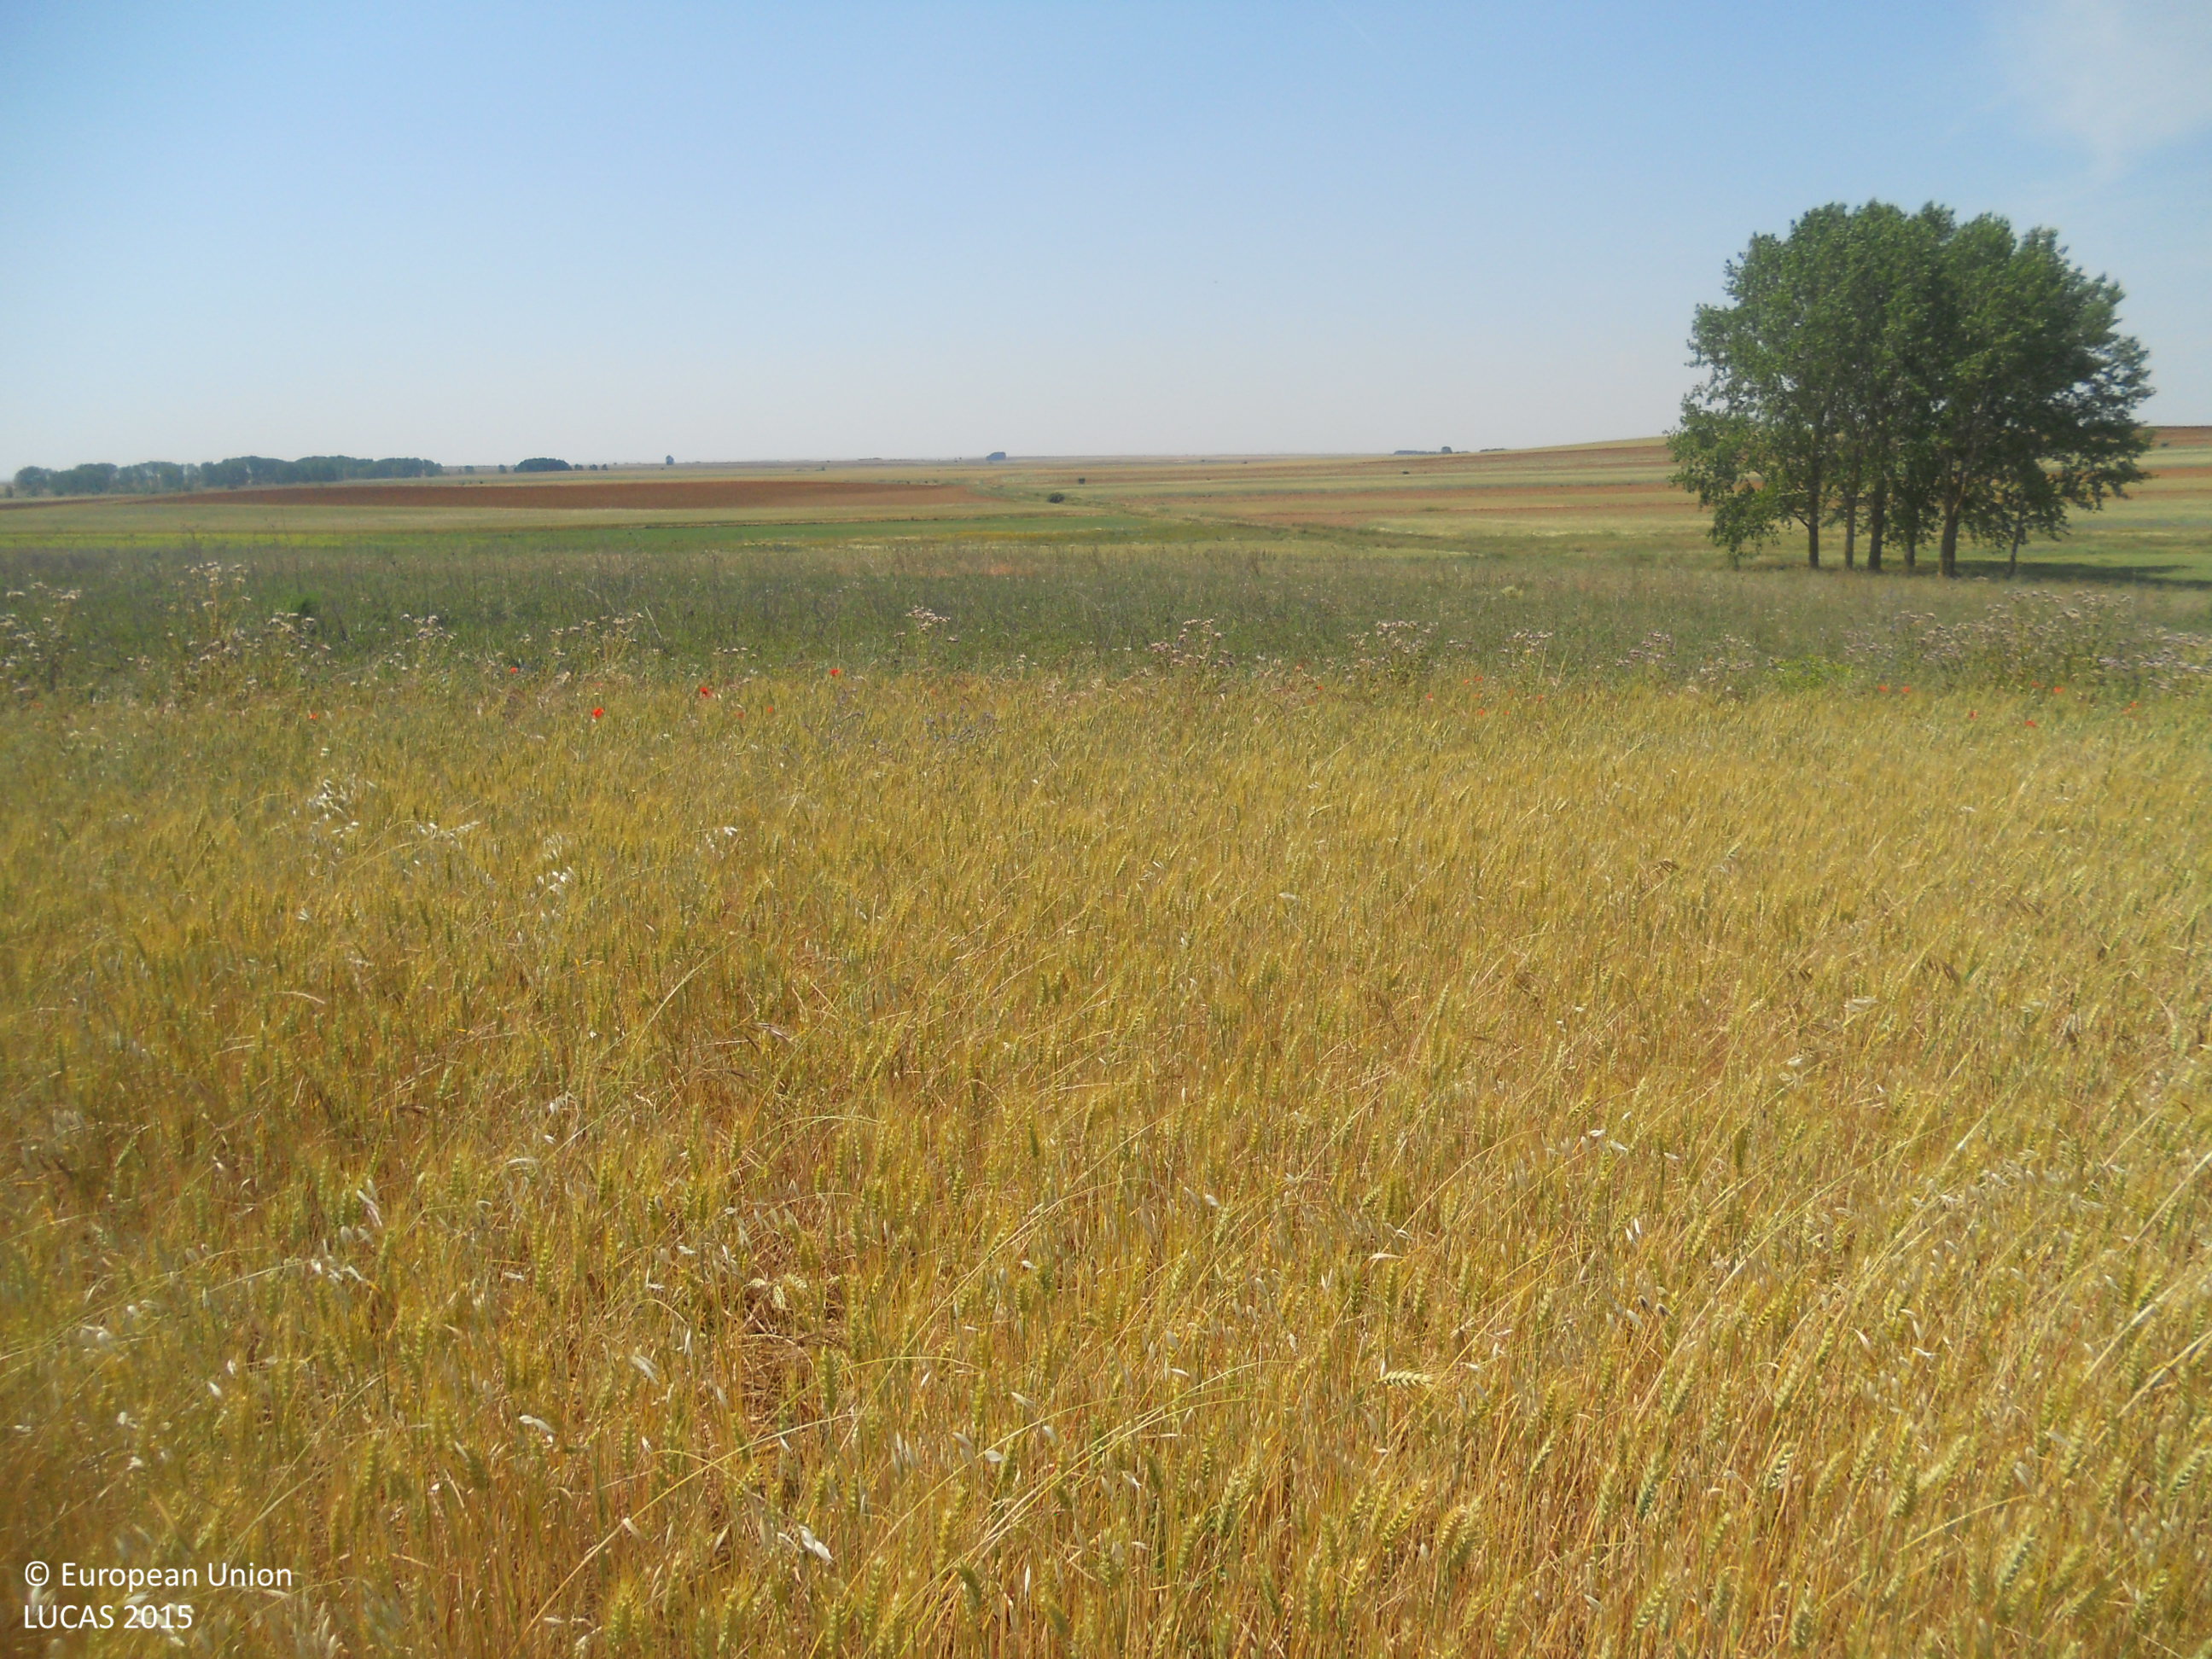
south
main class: Cropland
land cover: Common wheat
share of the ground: > 75 %
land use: Agriculture (excluding fallow land and kitchen gardens)
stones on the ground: < 10 %
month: June
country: ES
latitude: 42.3036
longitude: -5.3369
